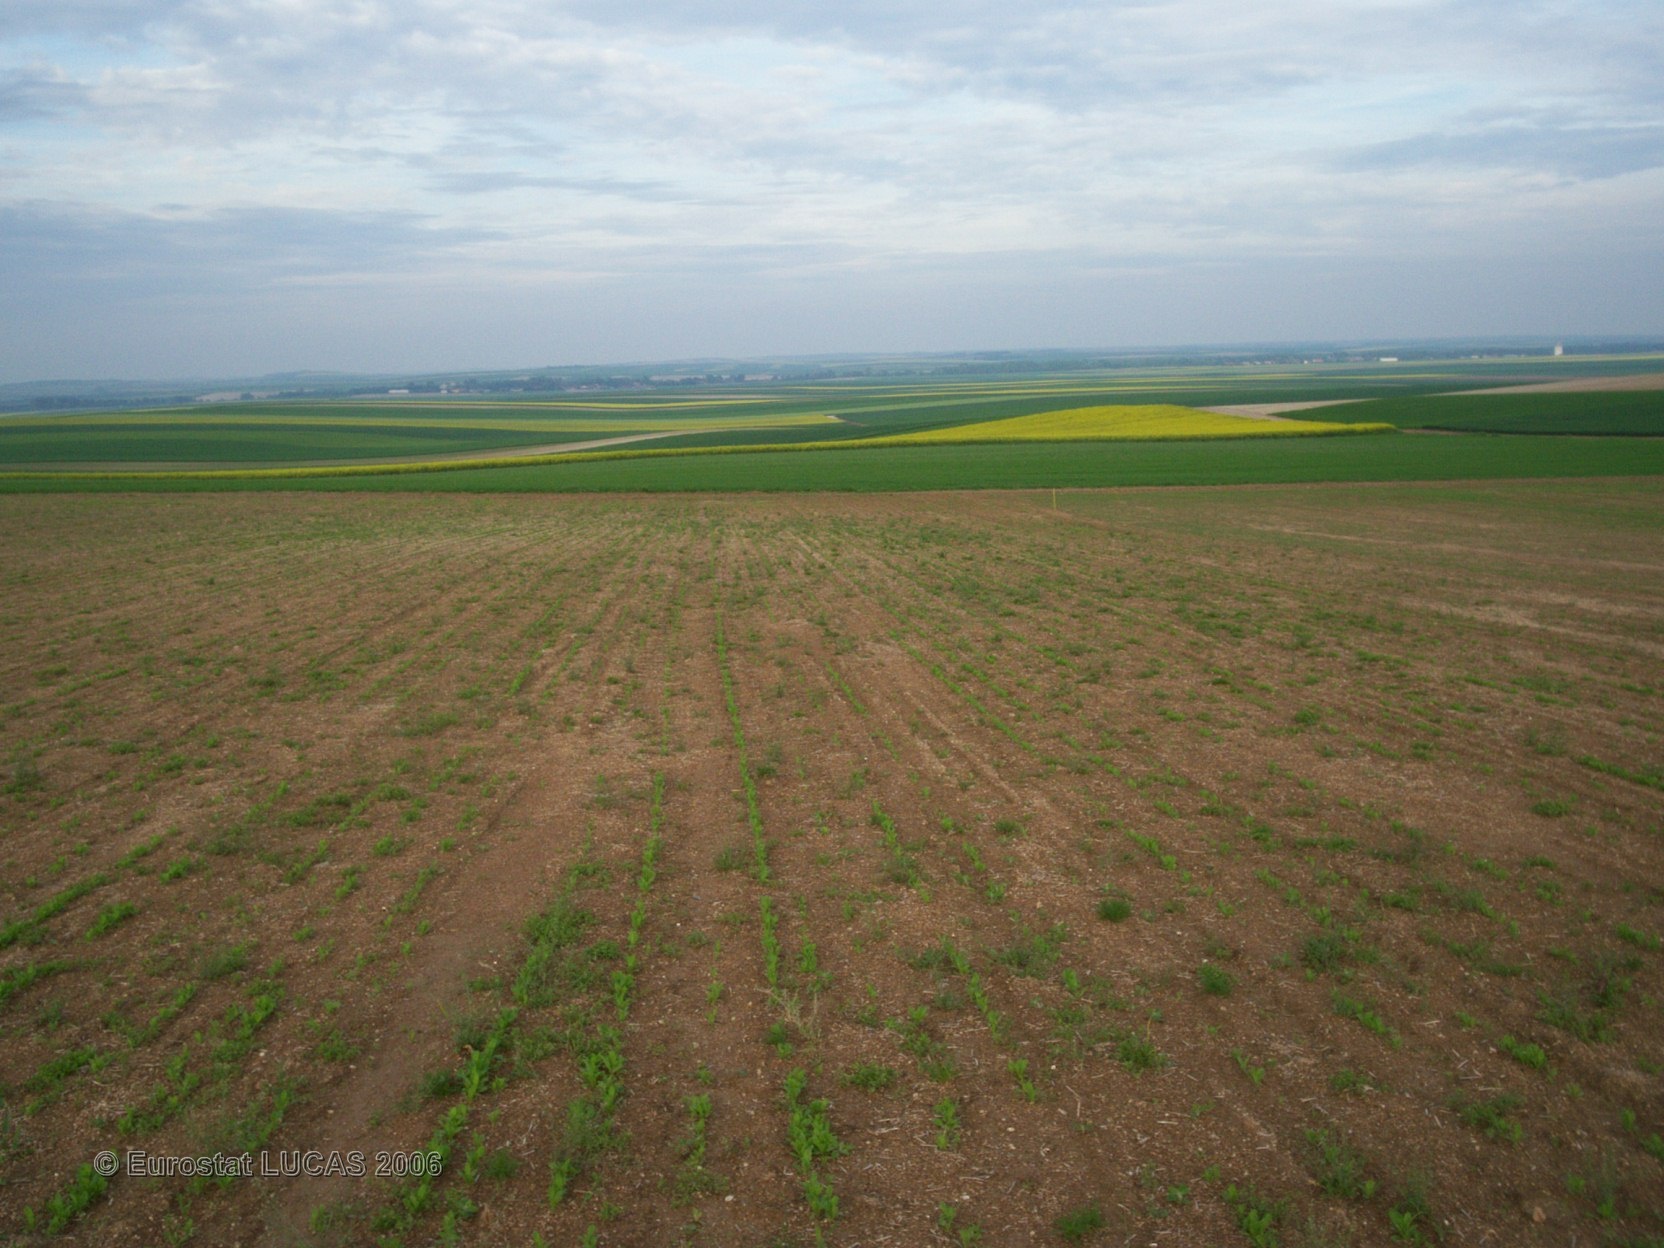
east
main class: Cropland
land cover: Other fibre and oleaginous crops
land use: Agriculture (excluding fallow land and kitchen gardens)
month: May
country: FR
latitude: 49.2150
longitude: 4.3538
